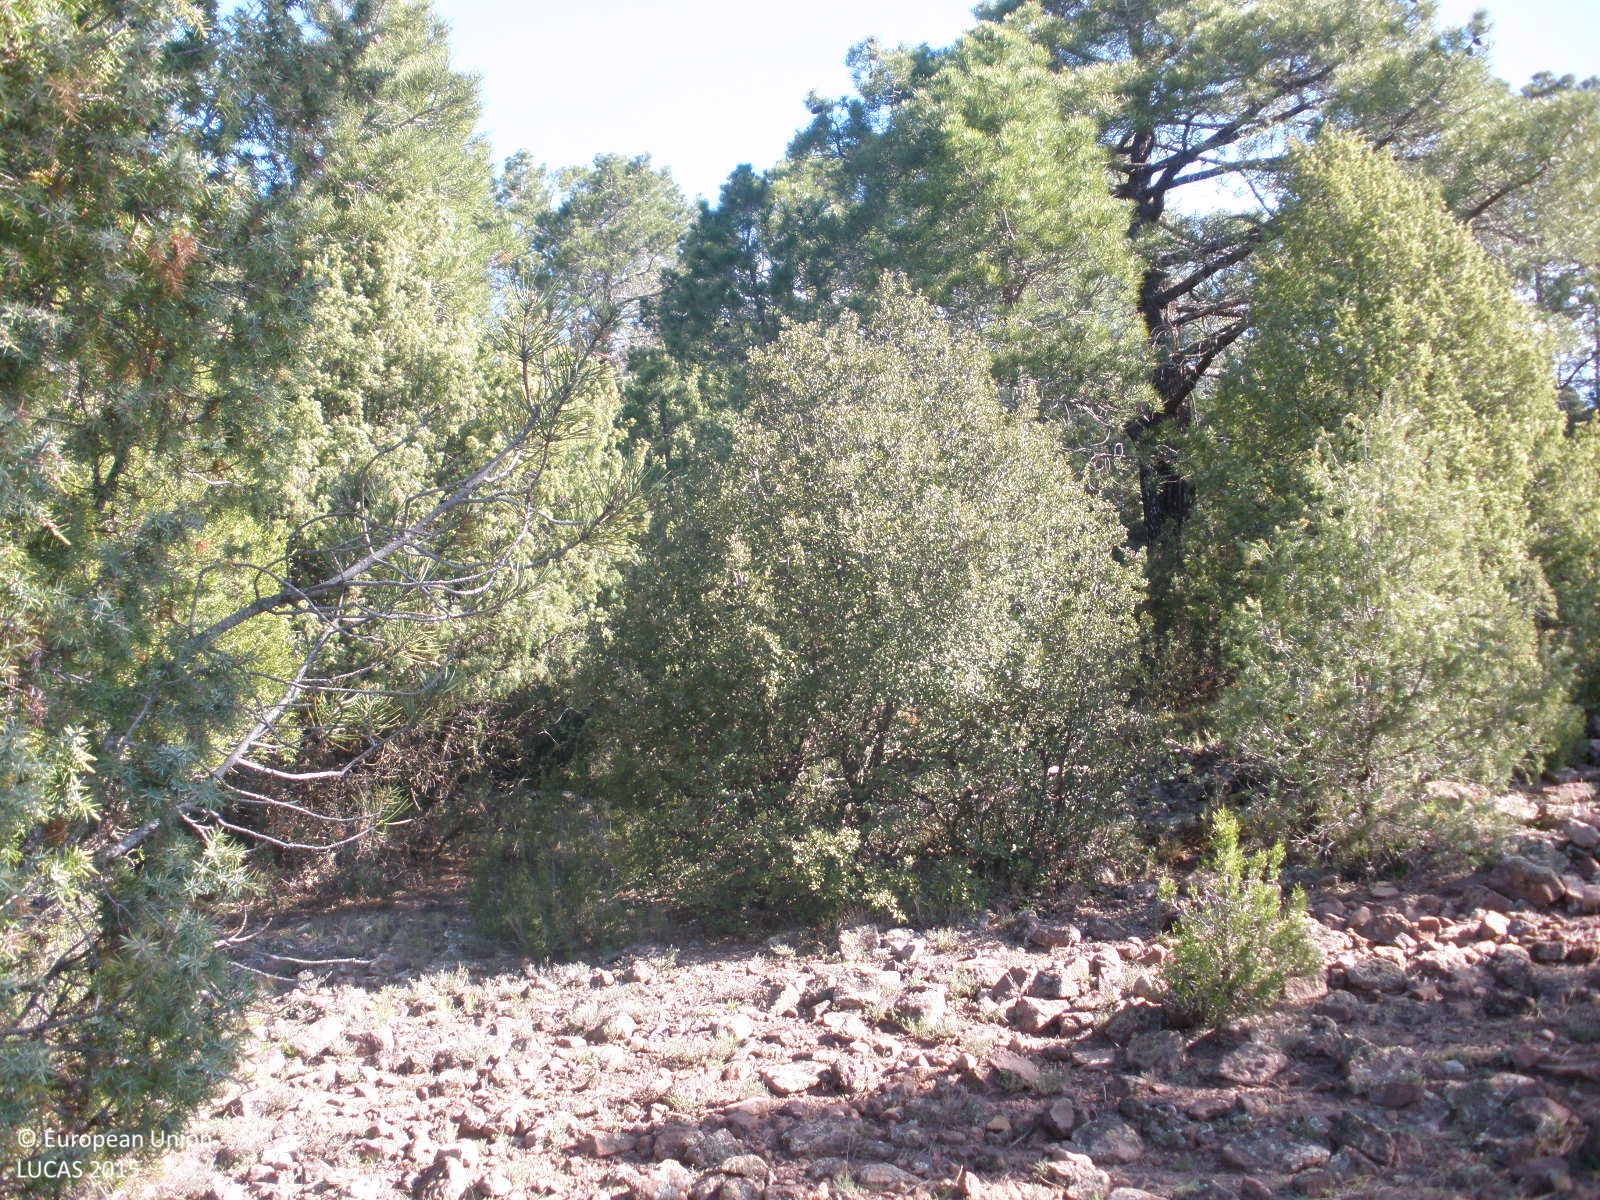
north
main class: Woodland
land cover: Other mixed woodland
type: coniferous forest of the mediterranean region
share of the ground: 50 - 75 %
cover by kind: consolidated bare surface 40 %, coniferous forest trees 30 %, broadleaved forest trees 20 %, shrubs 10 %
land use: Semi-natural and natural areas not in use
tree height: < 5 m
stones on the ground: 25 - 50 %
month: April
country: ES
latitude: 40.2951
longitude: -0.7484
